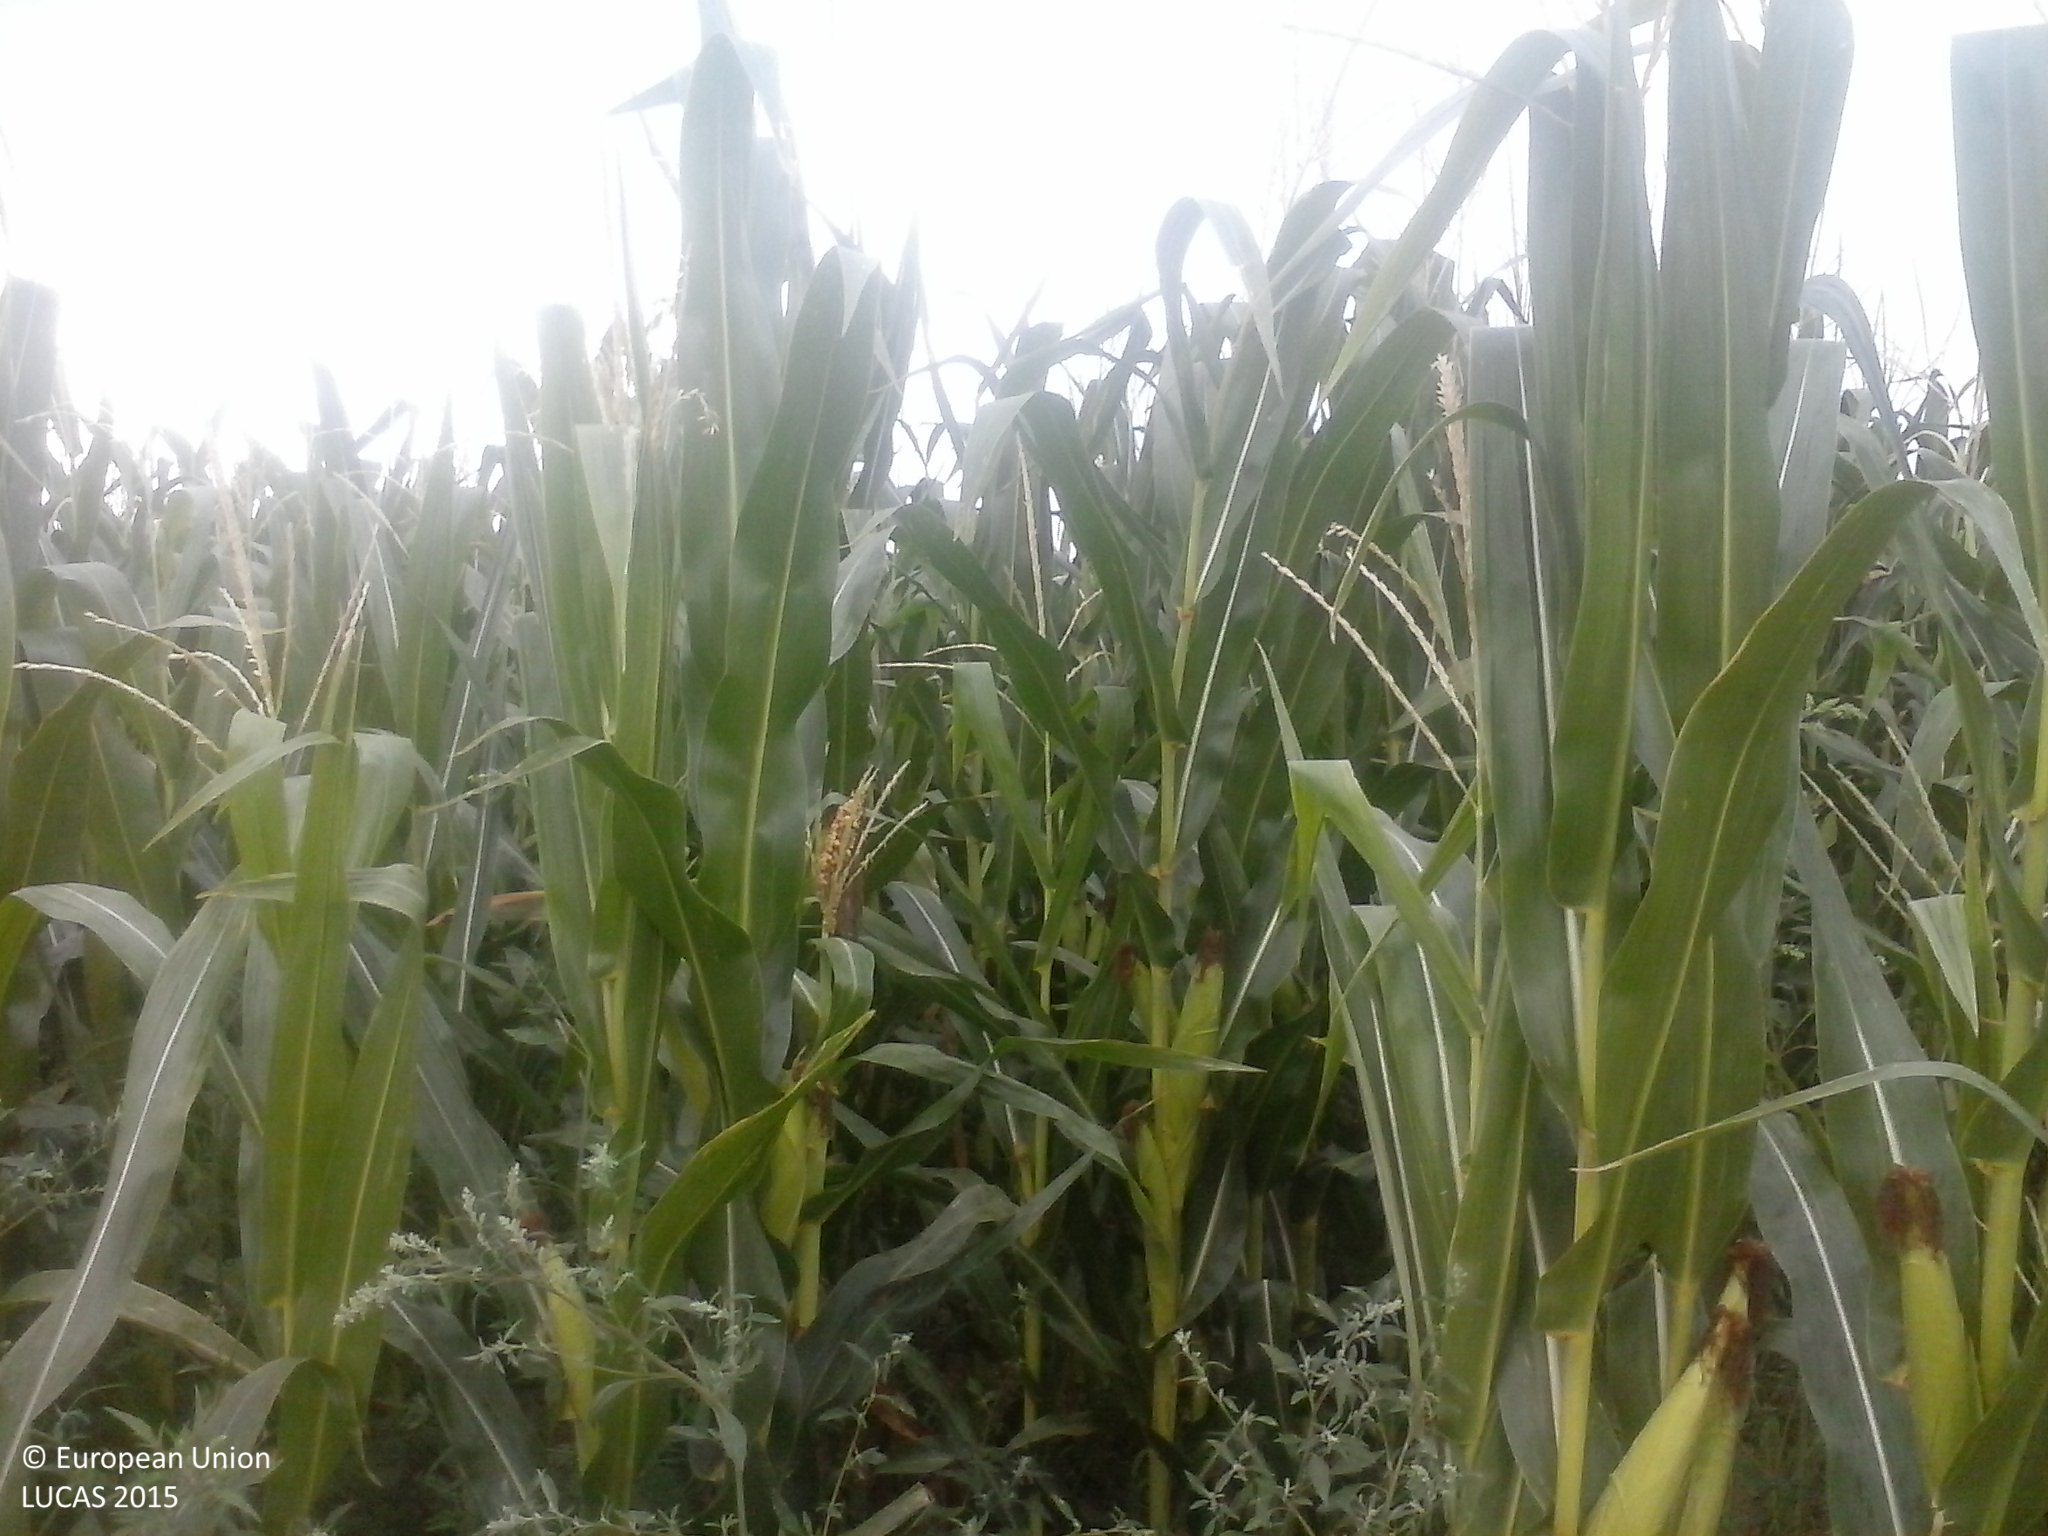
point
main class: Cropland
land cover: Maize
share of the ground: > 75 %
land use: Agriculture (excluding fallow land and kitchen gardens)
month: August
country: HU
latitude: 46.0111
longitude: 18.0520
